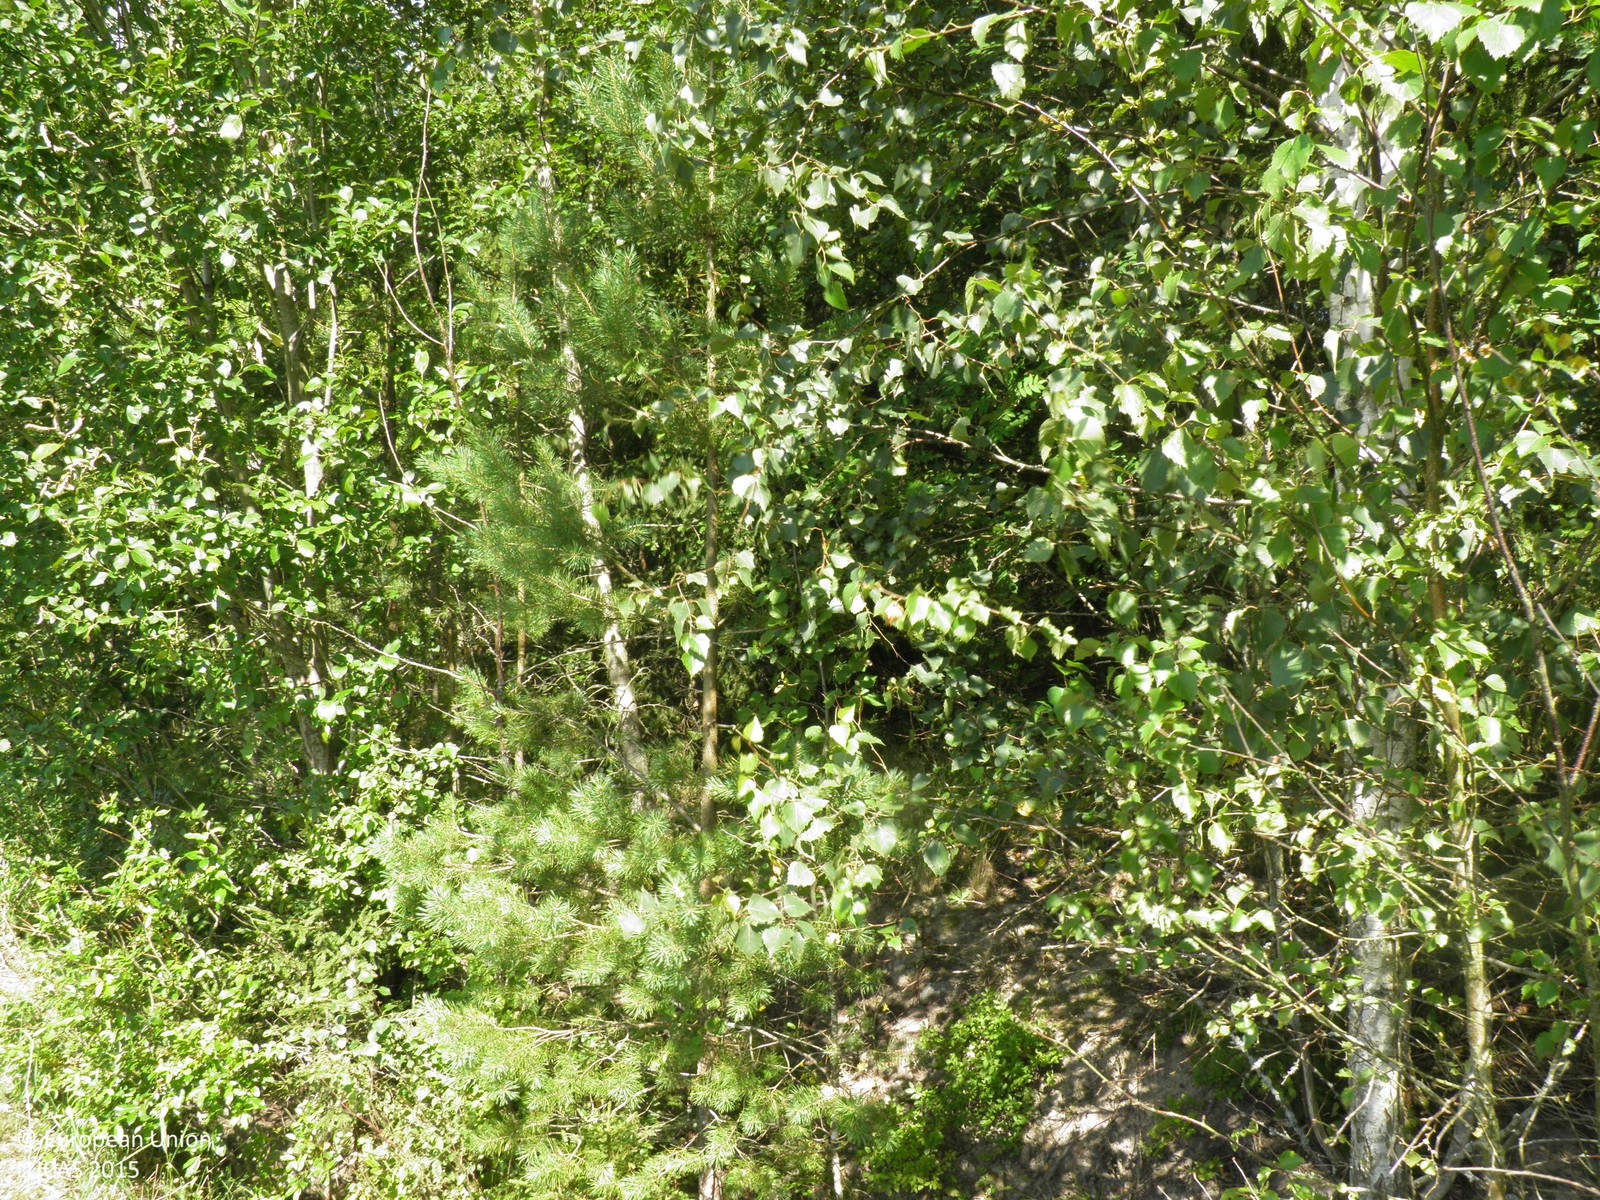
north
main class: Cropland
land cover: Barley
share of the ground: > 75 %
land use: Agriculture (excluding fallow land and kitchen gardens)
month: August
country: FI
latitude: 60.9381
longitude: 22.8997
